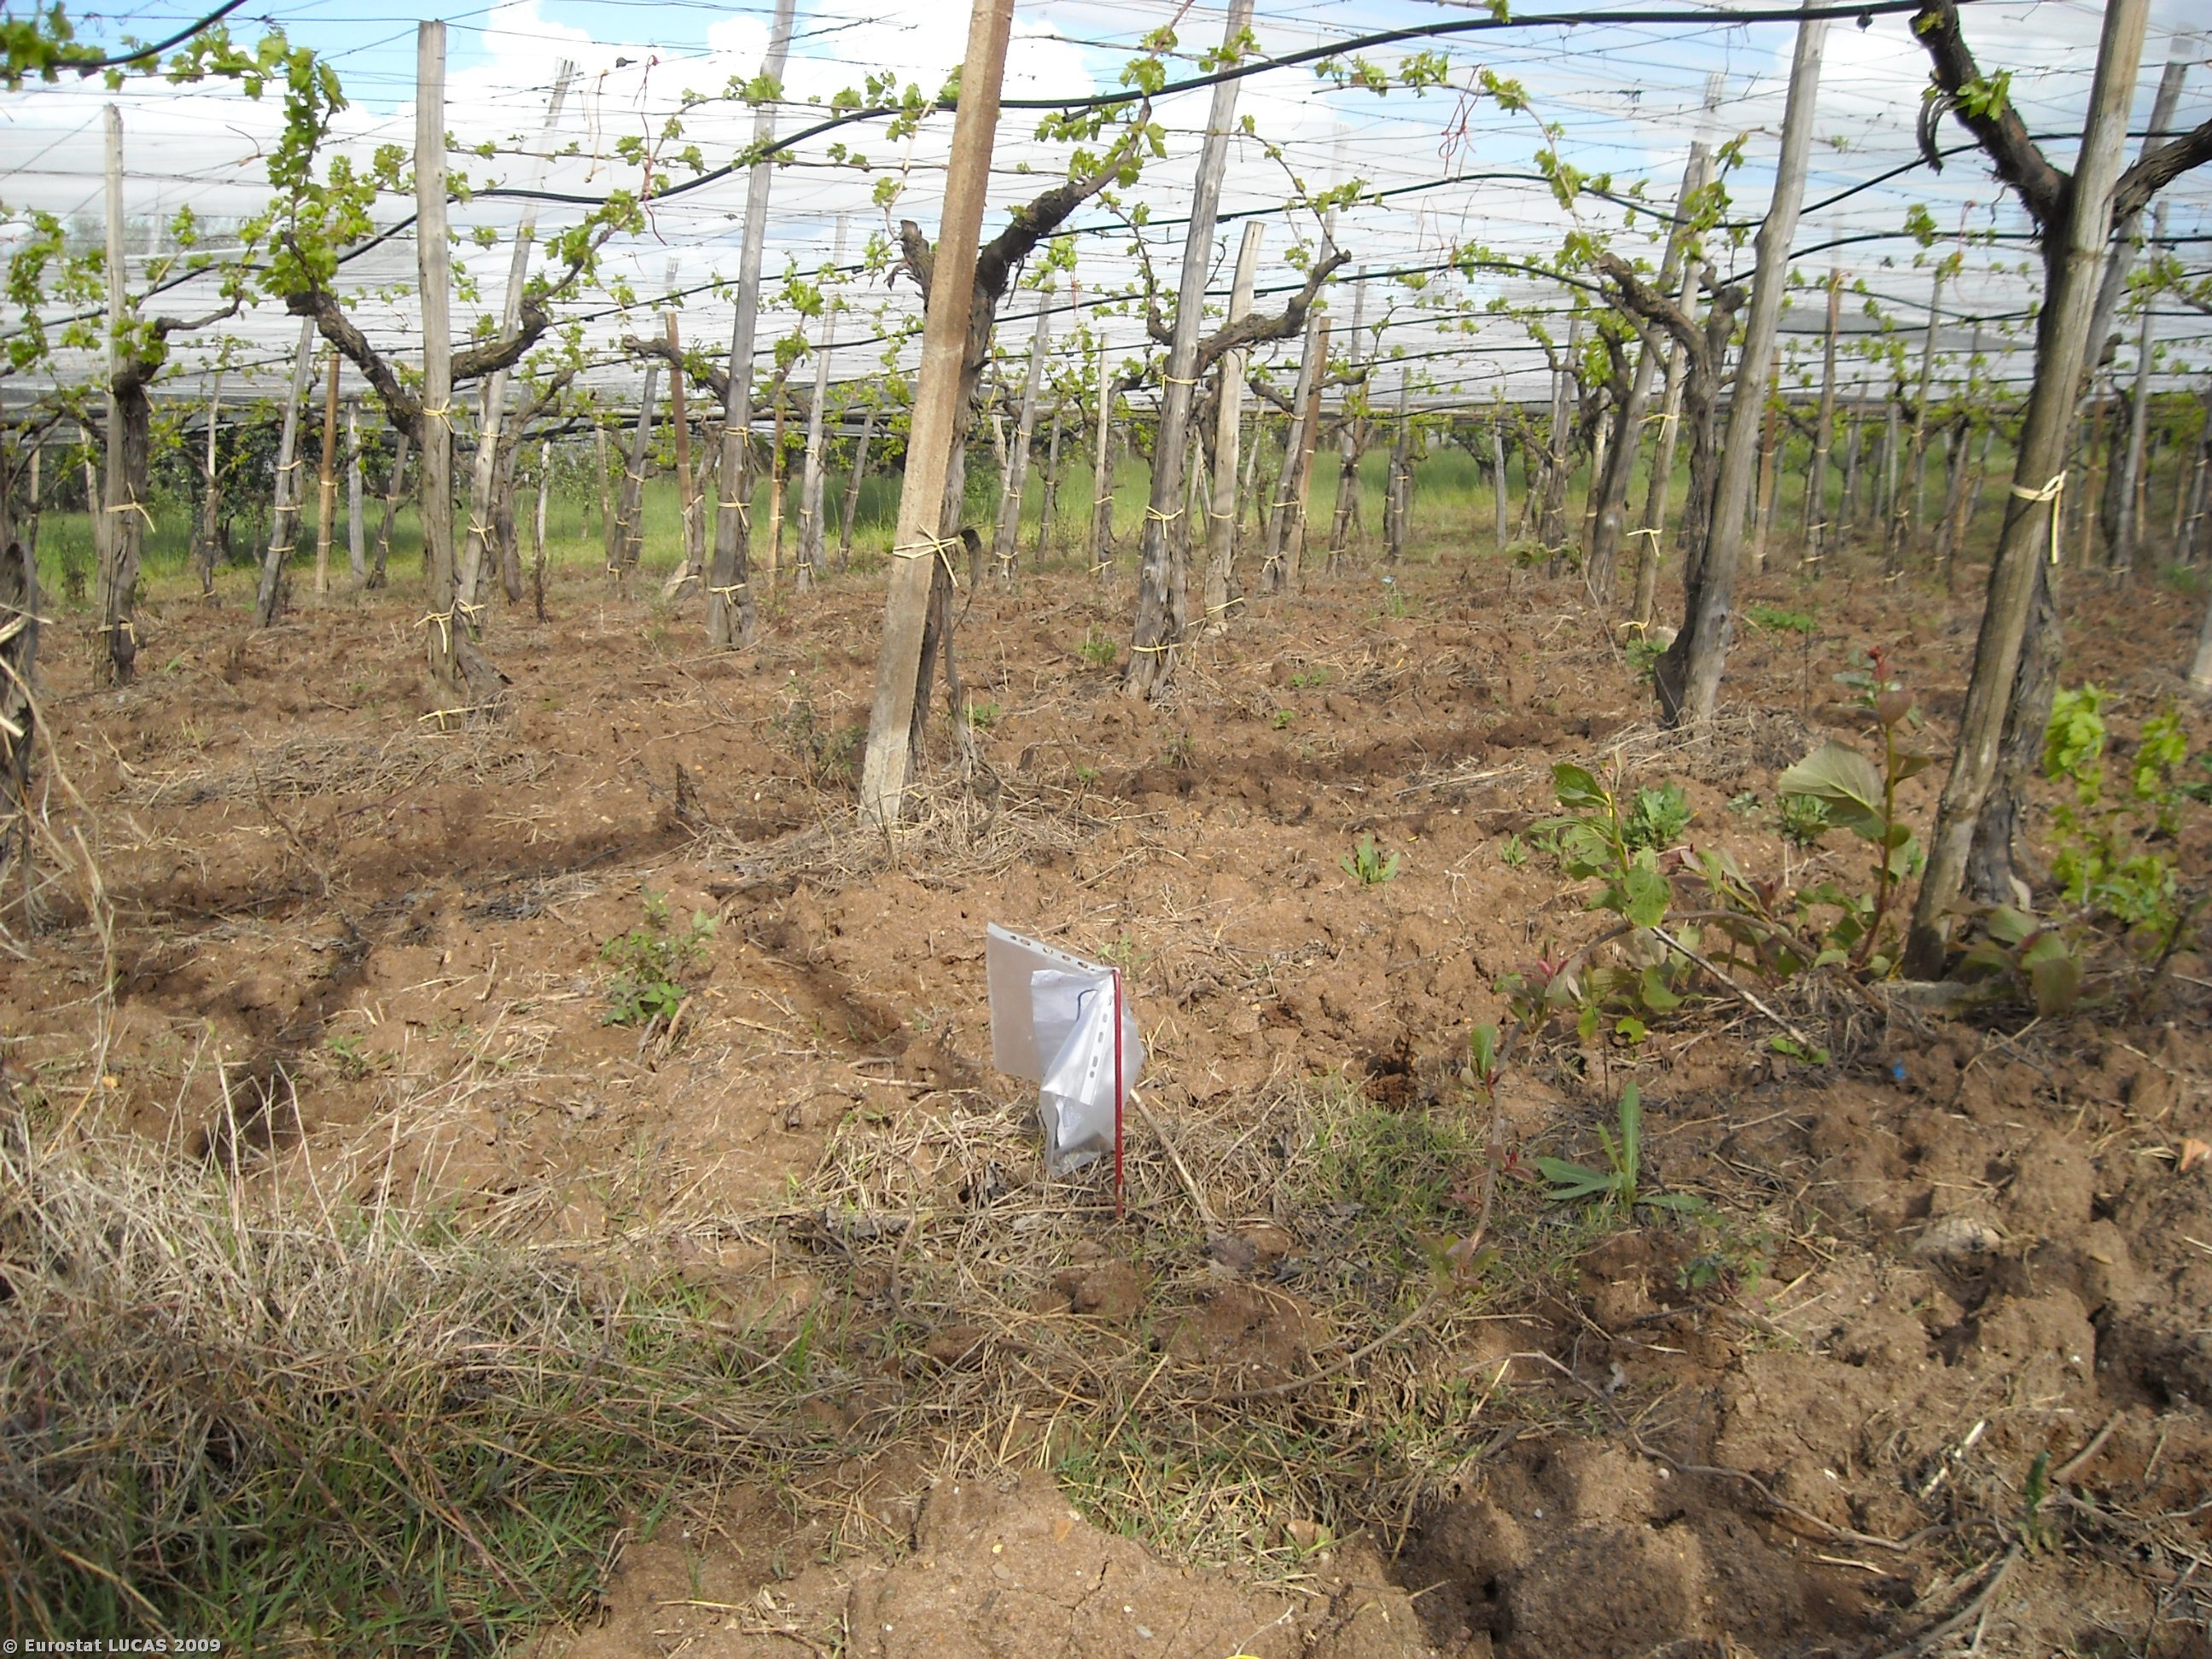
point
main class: Cropland
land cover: Vineyards
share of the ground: > 75 %
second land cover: Bare land
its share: > 75 %
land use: Agriculture (excluding fallow land and kitchen gardens)
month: April
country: IT
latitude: 40.5010
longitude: 16.8316
